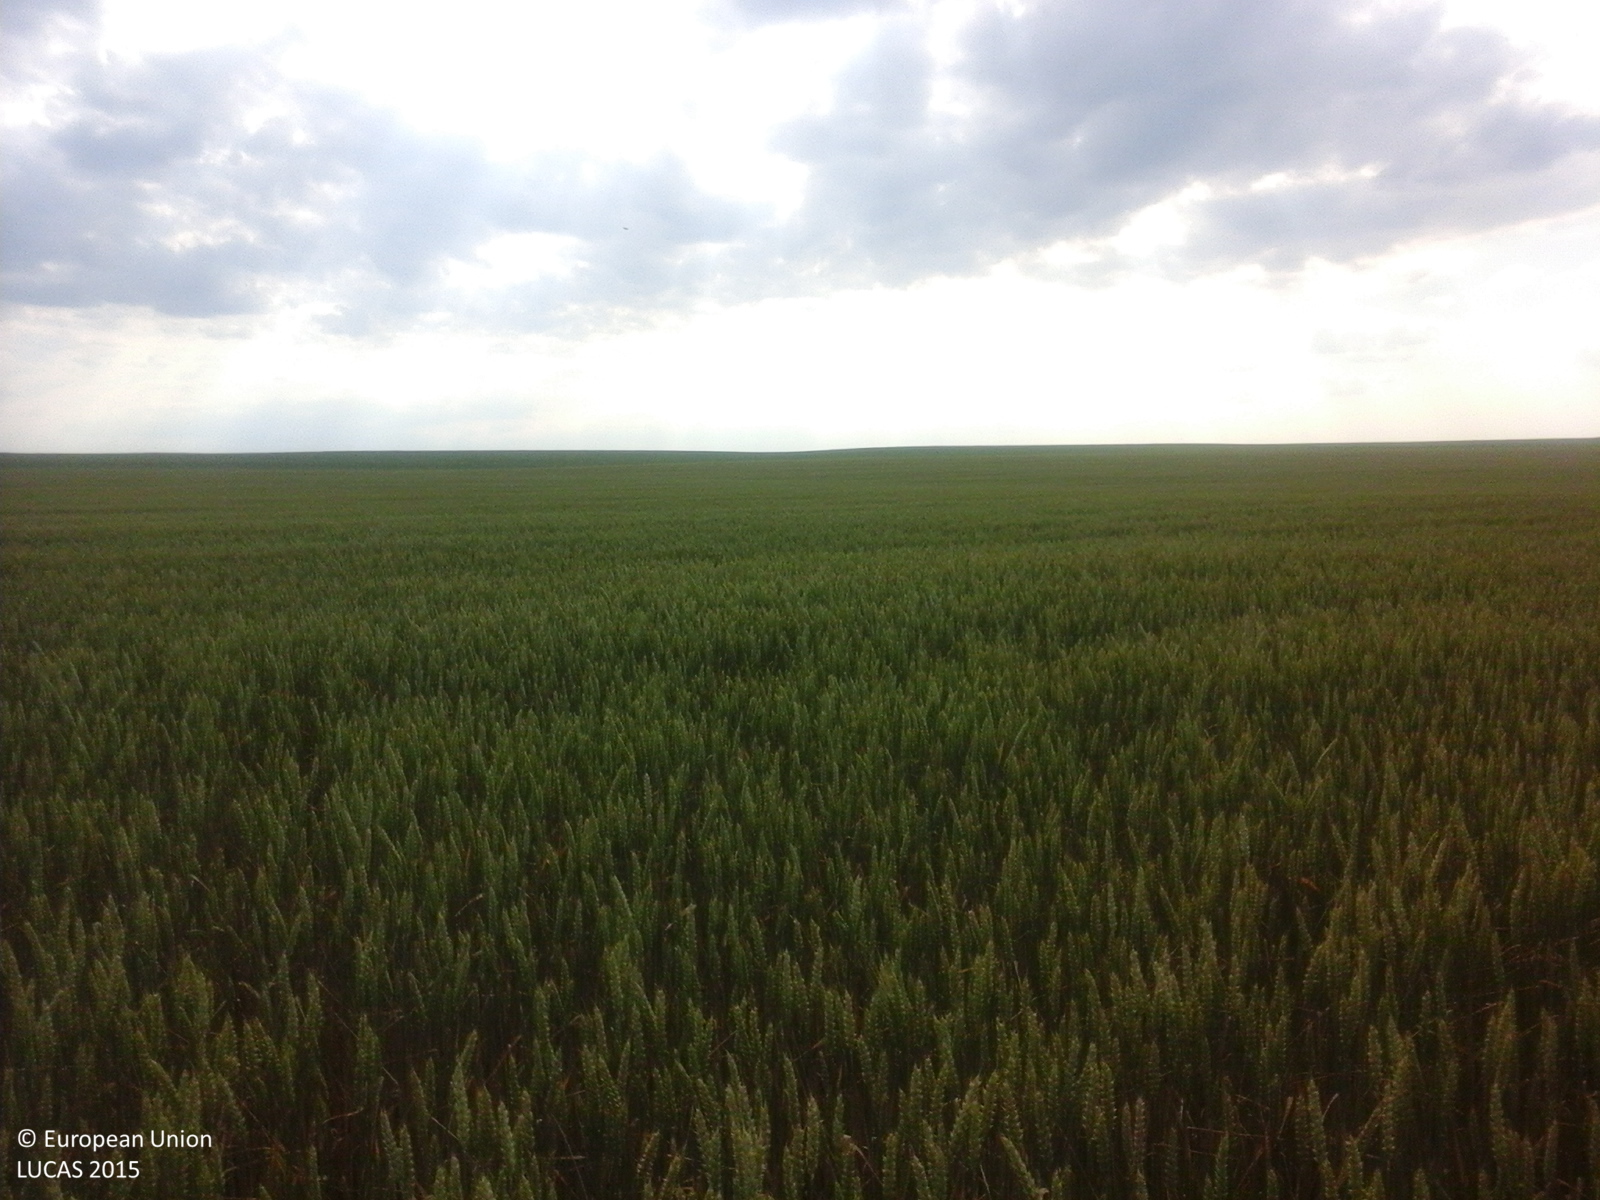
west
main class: Cropland
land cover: Common wheat
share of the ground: > 75 %
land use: Agriculture (excluding fallow land and kitchen gardens)
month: June
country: RO
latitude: 47.8869
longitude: 26.5006
